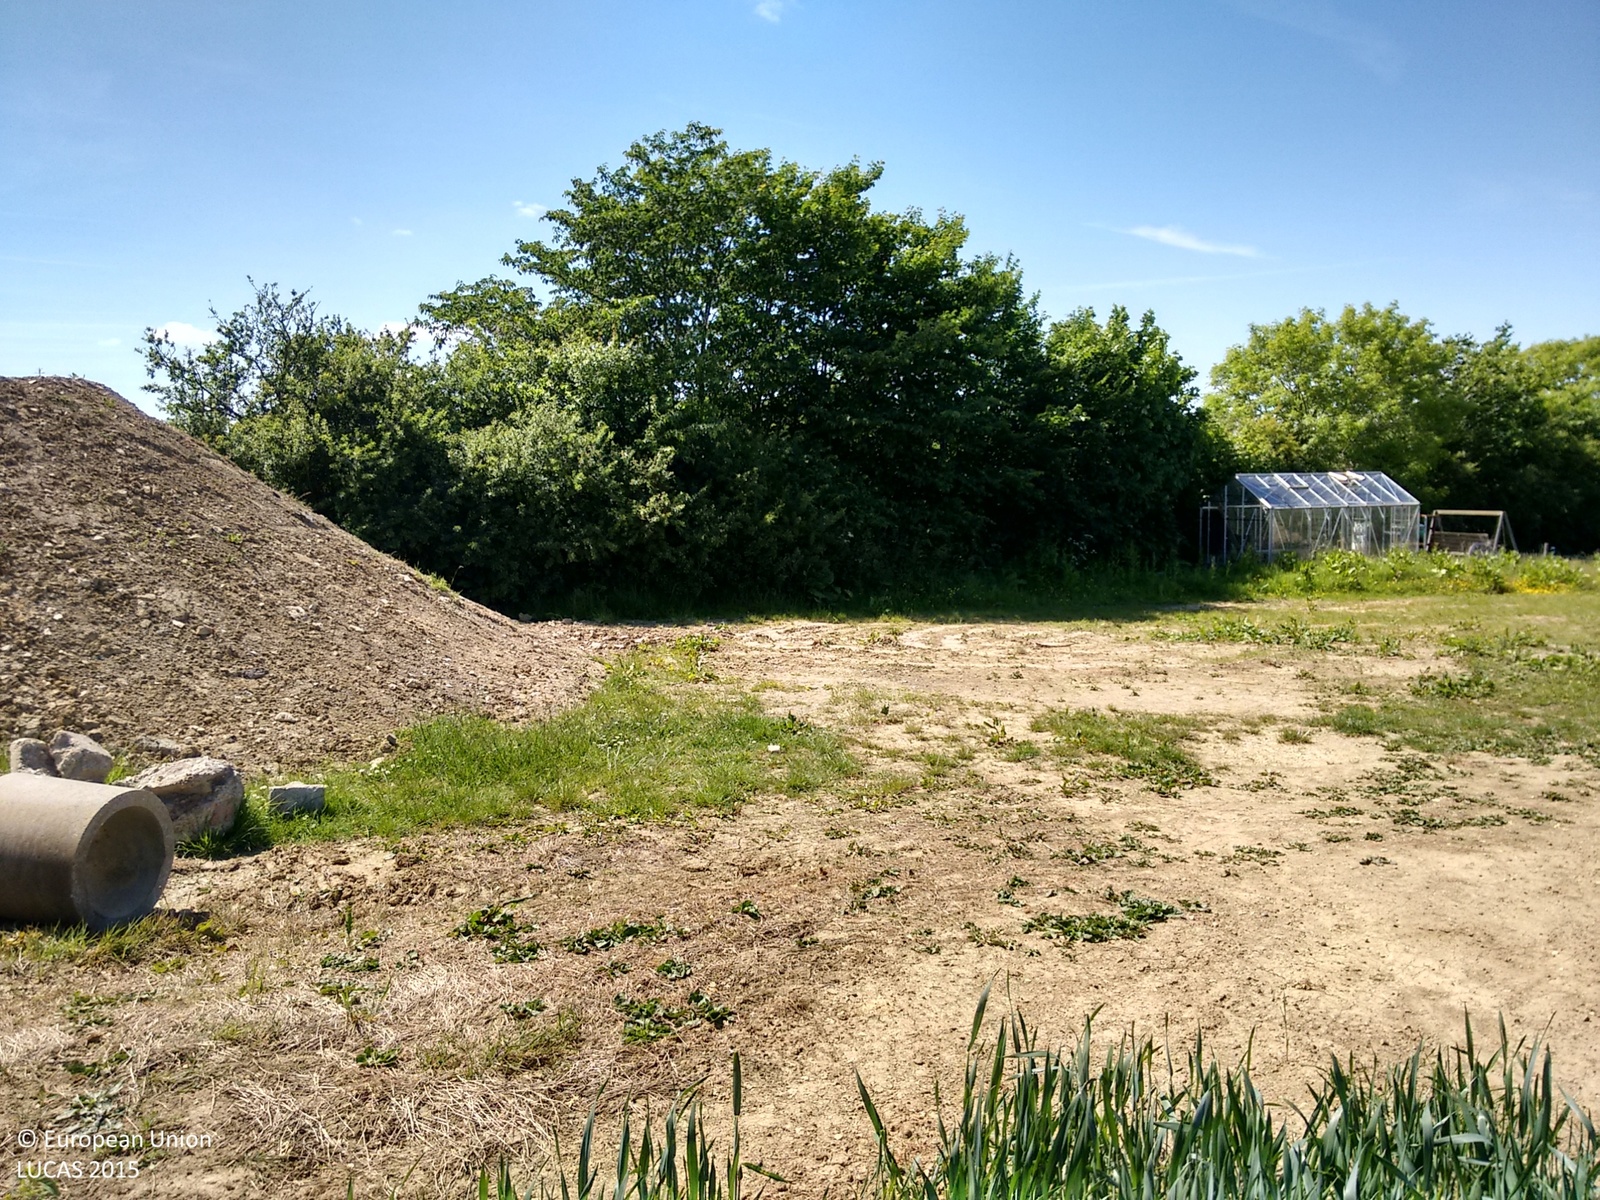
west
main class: Cropland
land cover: Common wheat
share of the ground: > 75 %
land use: Agriculture (excluding fallow land and kitchen gardens)
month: June
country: GB
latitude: 54.0543
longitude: -0.8713
